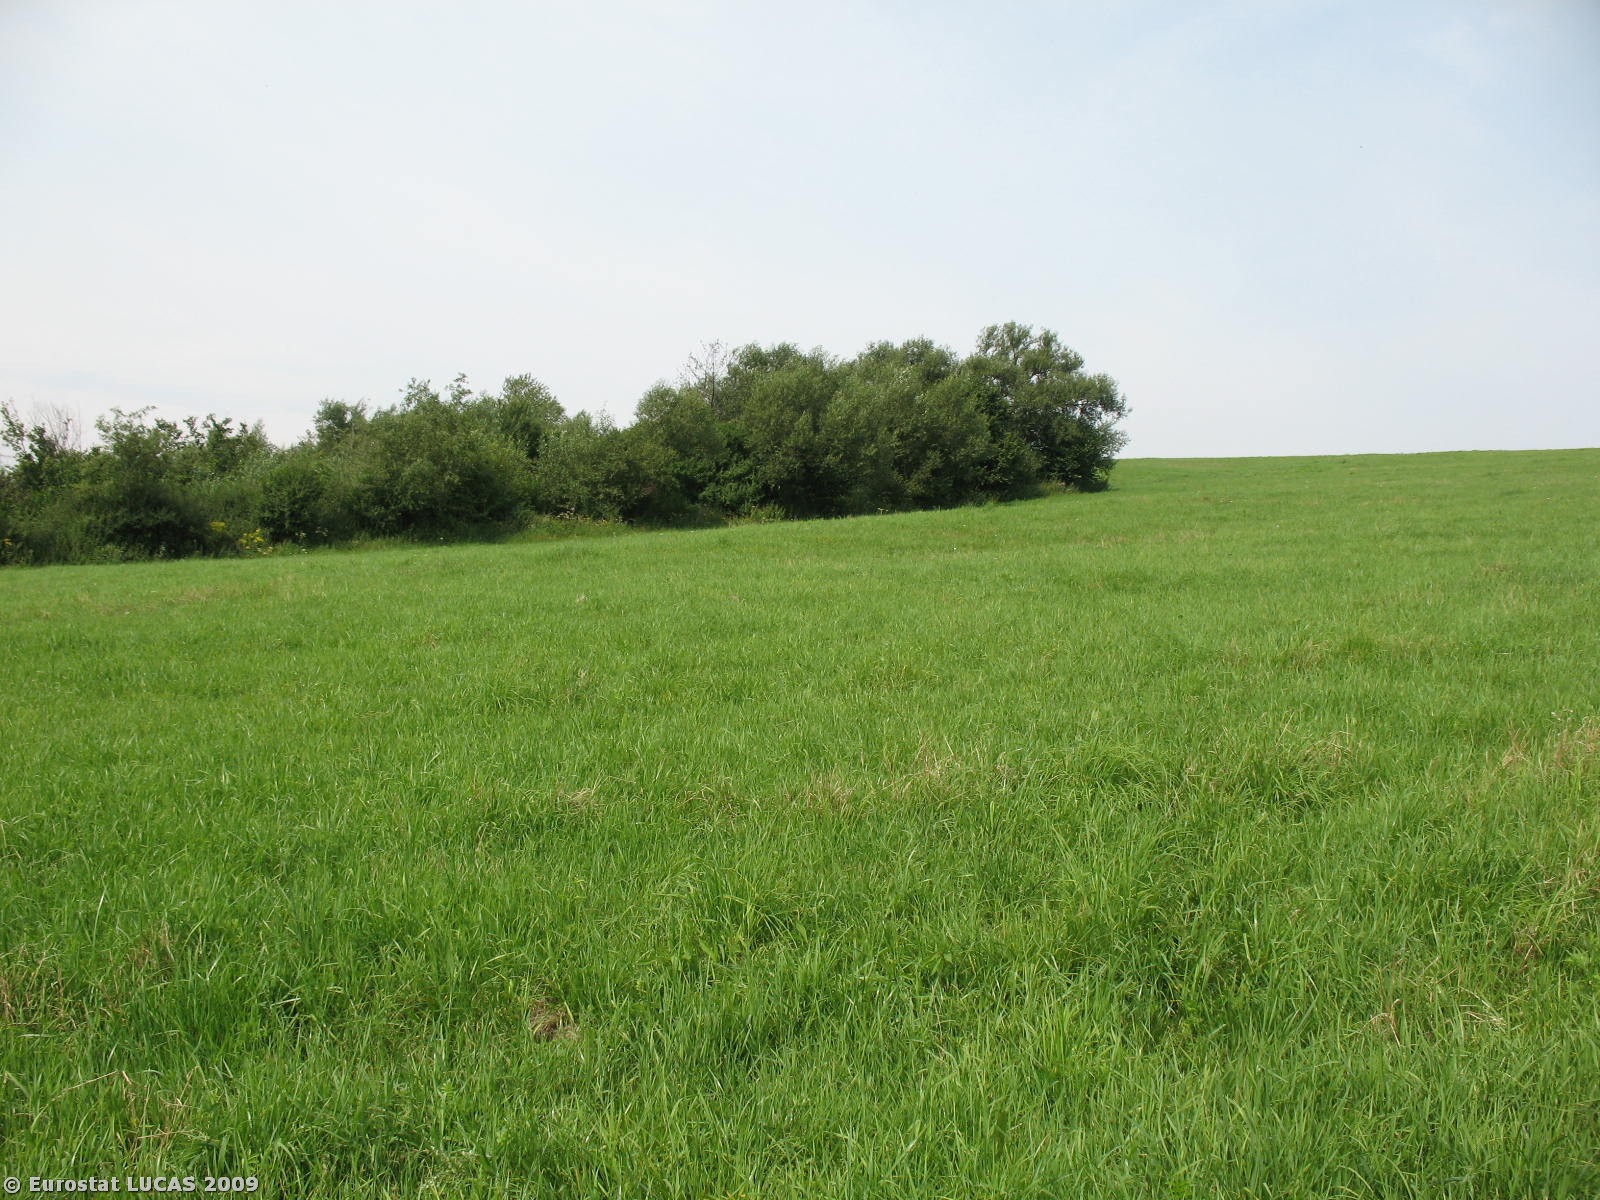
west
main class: Shrubland
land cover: Shrubland with sparse tree cover
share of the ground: > 75 %
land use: Nature reserves
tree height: > 5 m
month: August
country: PL
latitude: 49.7615
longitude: 22.3765
